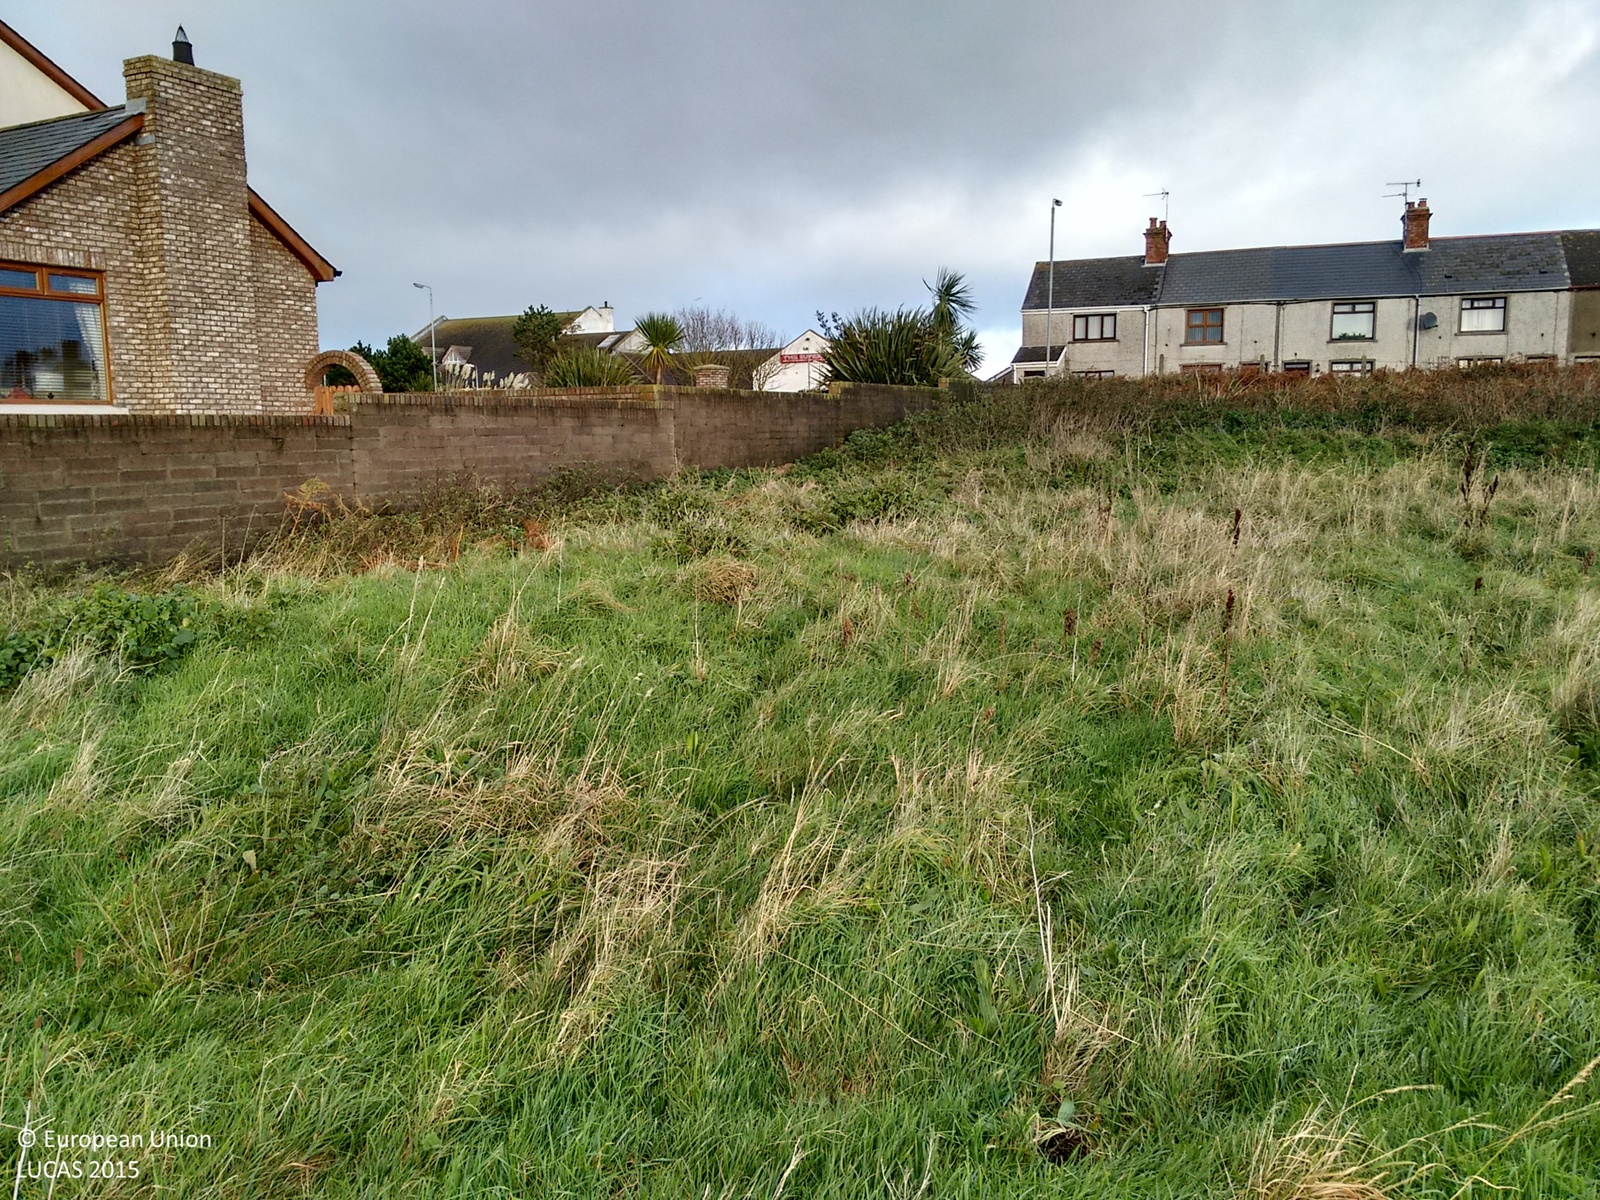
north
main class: Grassland
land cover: Grassland without tree/shrub cover
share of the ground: > 75 %
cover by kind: herbaceous plants 100 %
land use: Agriculture (excluding fallow land and kitchen gardens)
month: November
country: GB
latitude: 54.4558
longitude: -5.4428
